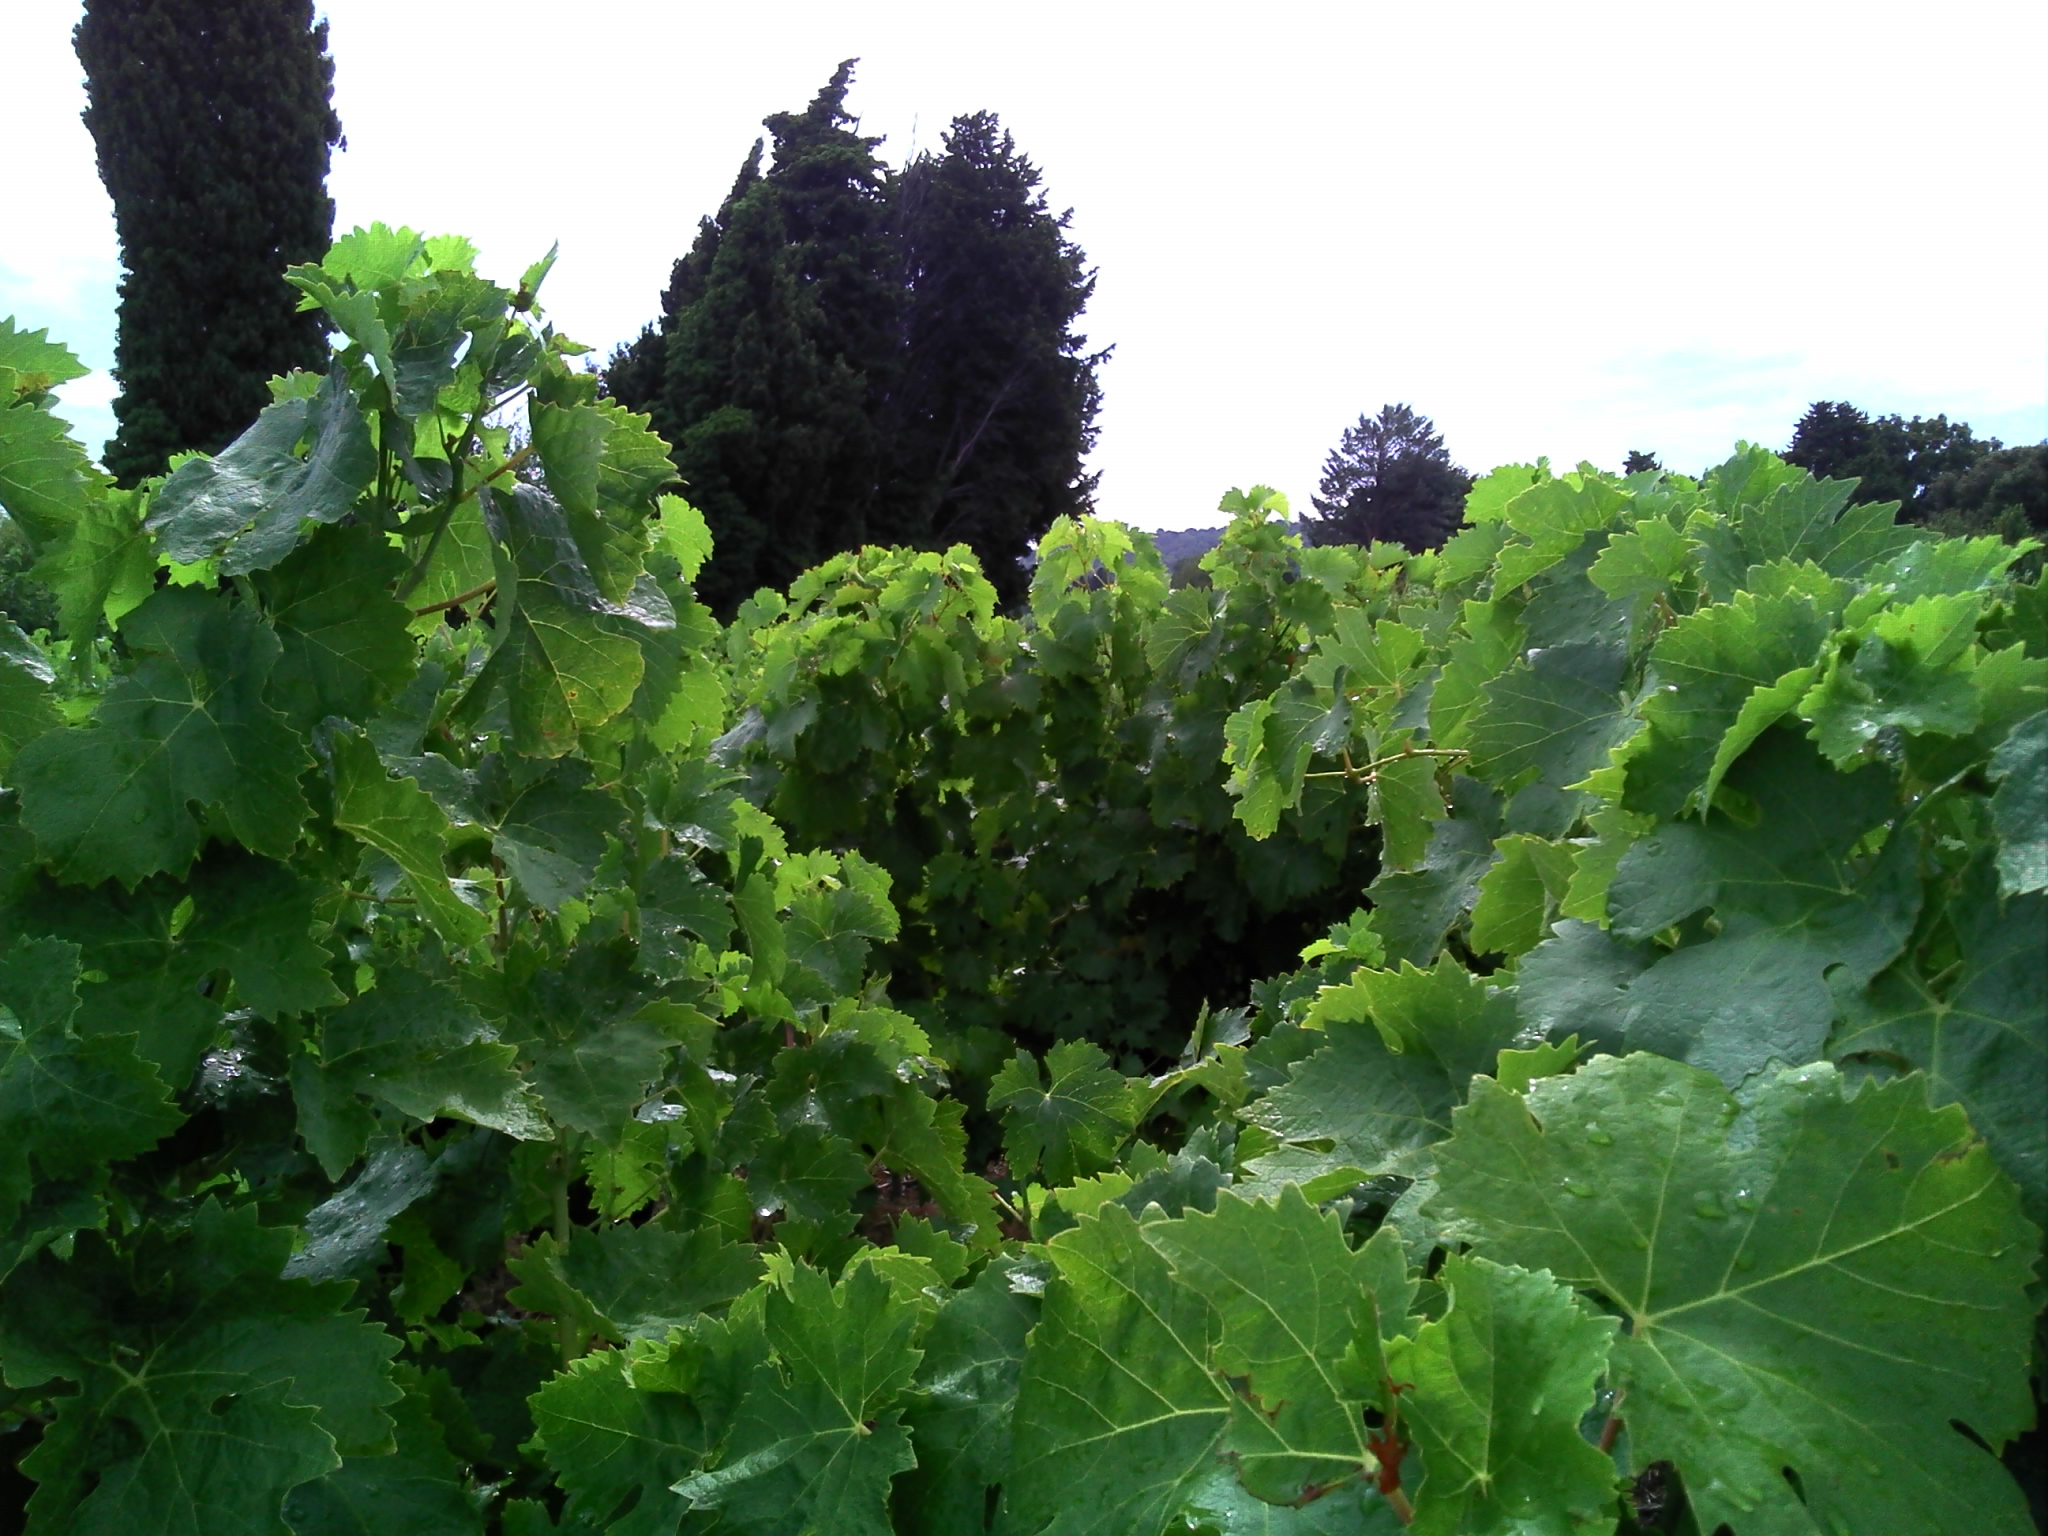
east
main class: Cropland
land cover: Vineyards
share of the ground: 25 - 50 %
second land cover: Spontaneously vegetated surfaces
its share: 50 - 75 %
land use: Agriculture (excluding fallow land and kitchen gardens)
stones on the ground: < 10 %
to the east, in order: Vineyards; Spontaneously vegetated surfaces; Ditches and canals; Grass margins; Paved roads, cycling and walking lanes; Grass margins; Ditches and canals; Artificial constructions in urban areas; Vineyards; Ditches and canals; Vineyards; Ditches and canals; Fences; Spontaneously vegetated surfaces; Other fresh vegetables; Fences; Grassland with sparse tree/shrub cover
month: August
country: FR
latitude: 44.0681
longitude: 4.6520
